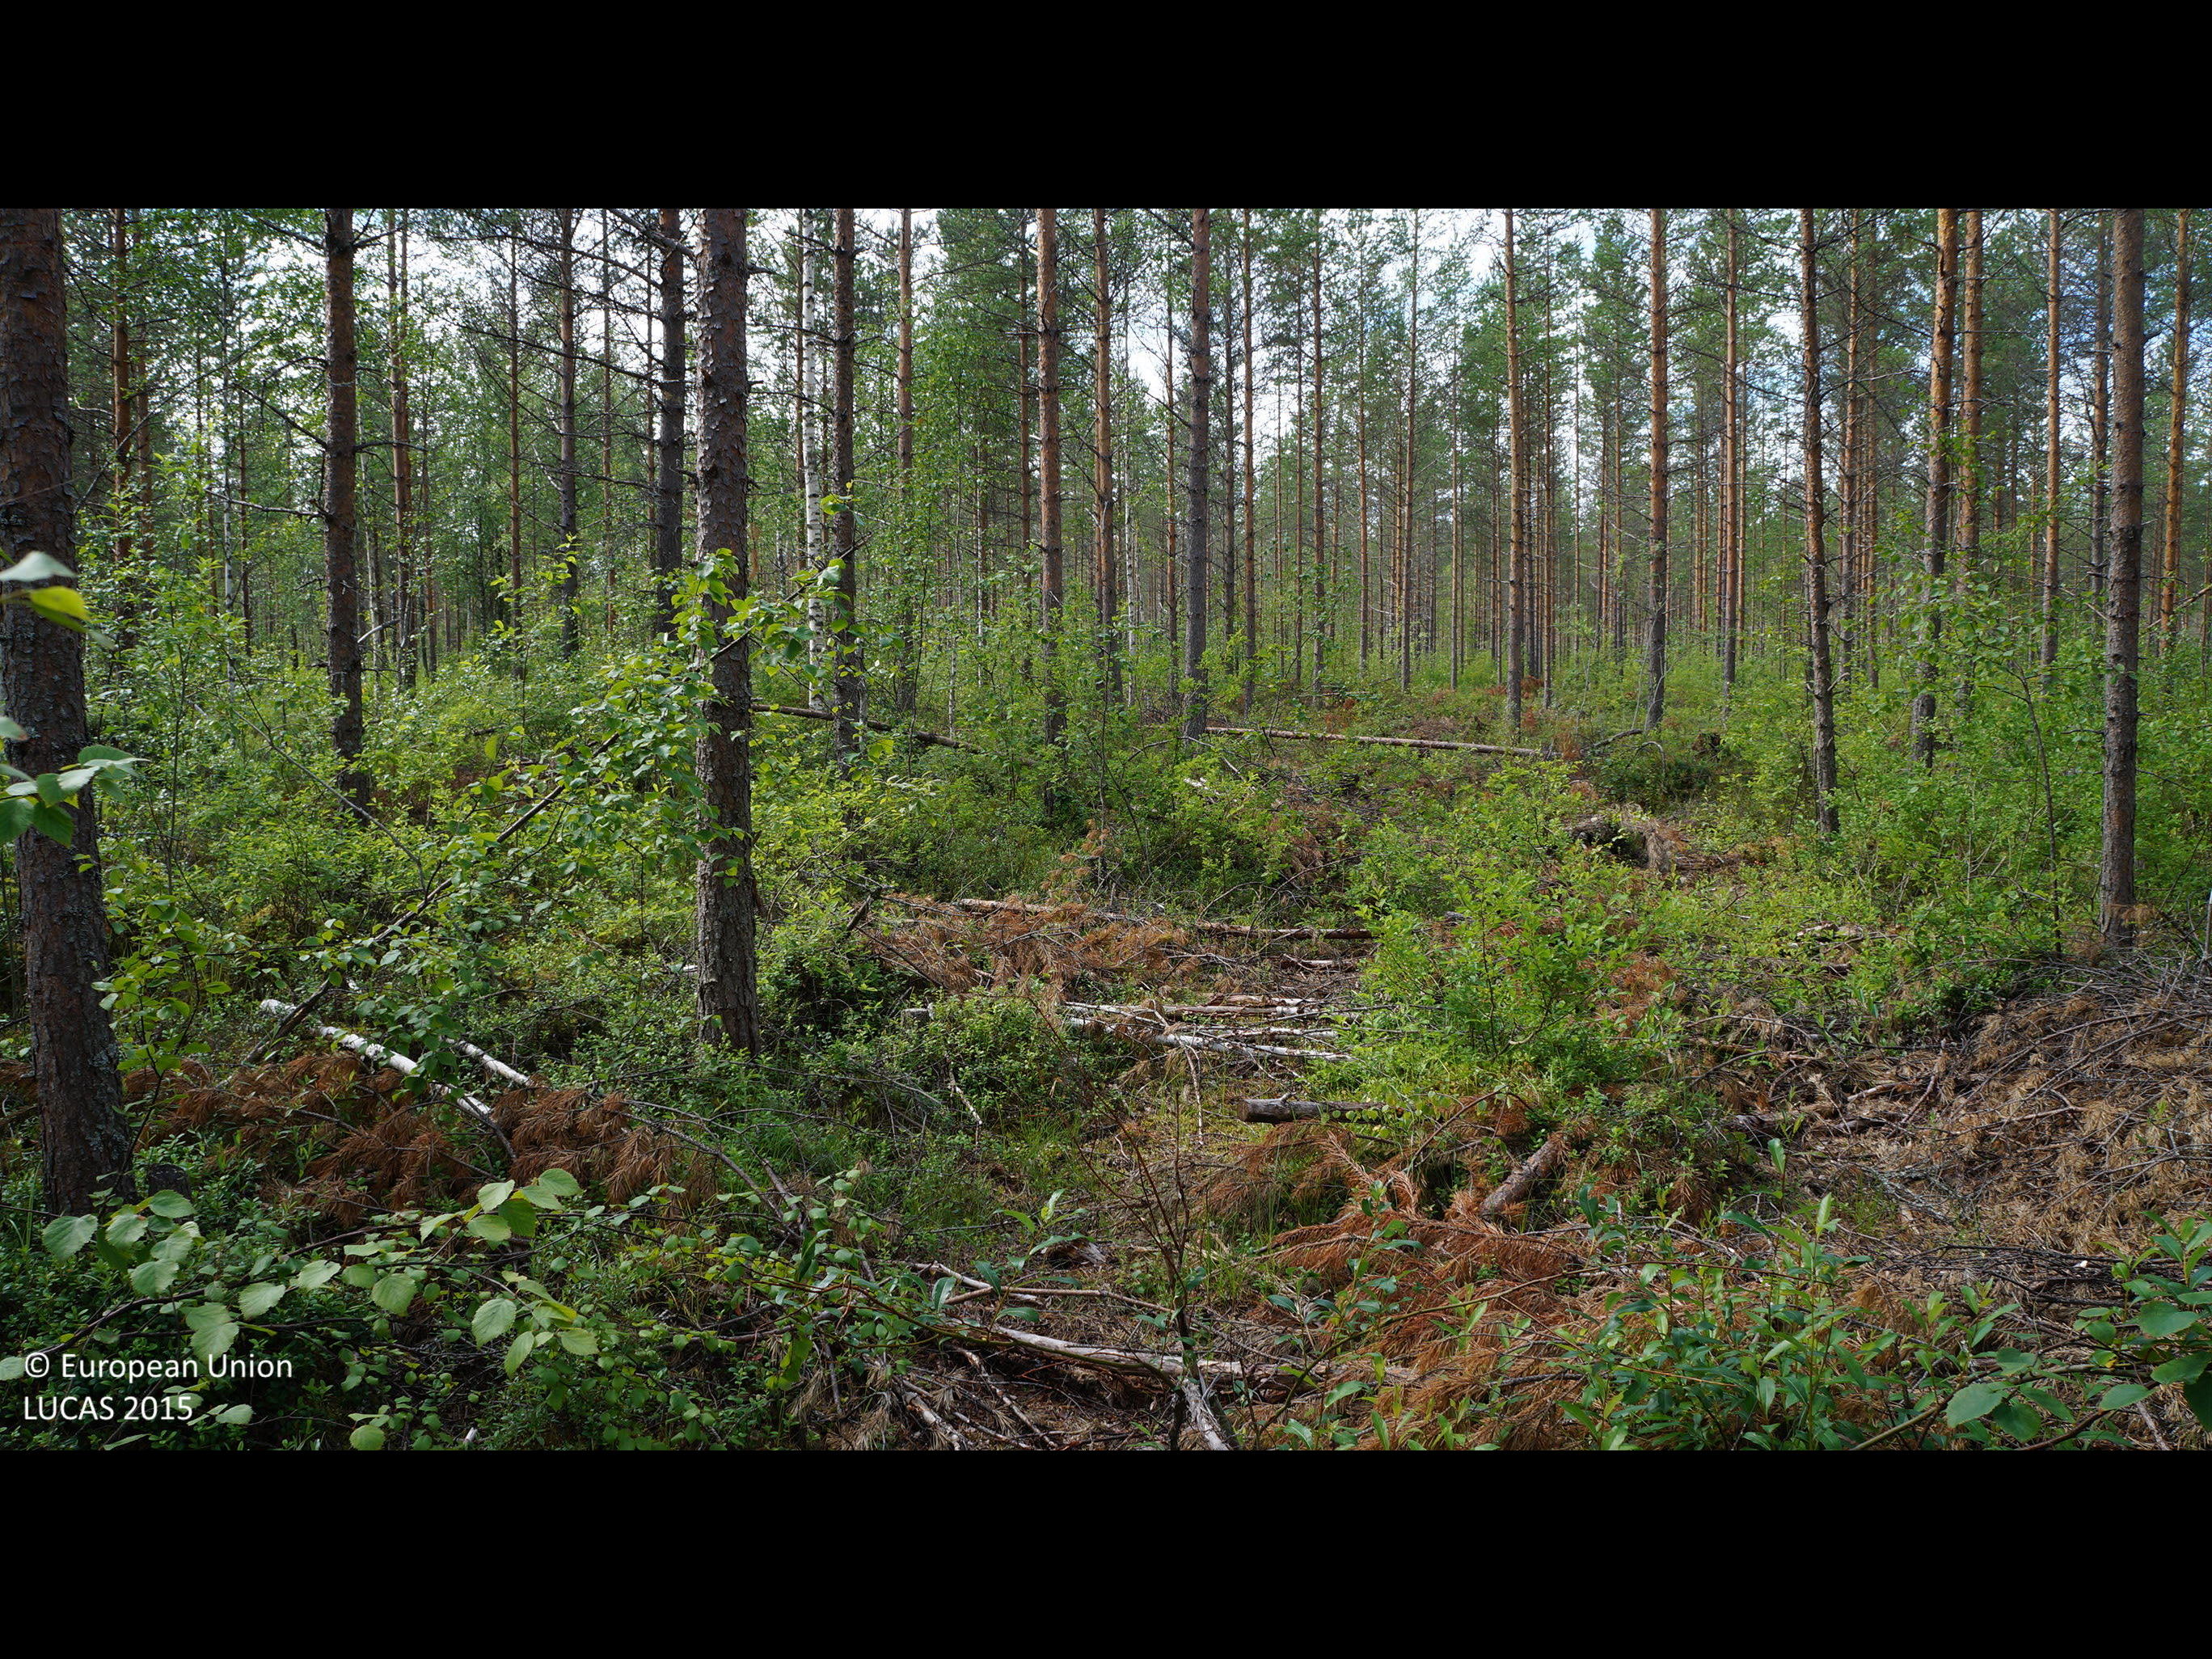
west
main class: Woodland
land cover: Pine dominated coniferous woodland
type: boreal forest
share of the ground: 25 - 50 %
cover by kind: shrubs 50 %, coniferous forest trees 40 %, herbaceous plants 5 %, lichens and mosses 5 %
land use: Forestry
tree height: > 5 m
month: July
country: FI
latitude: 64.0296
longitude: 24.4205
